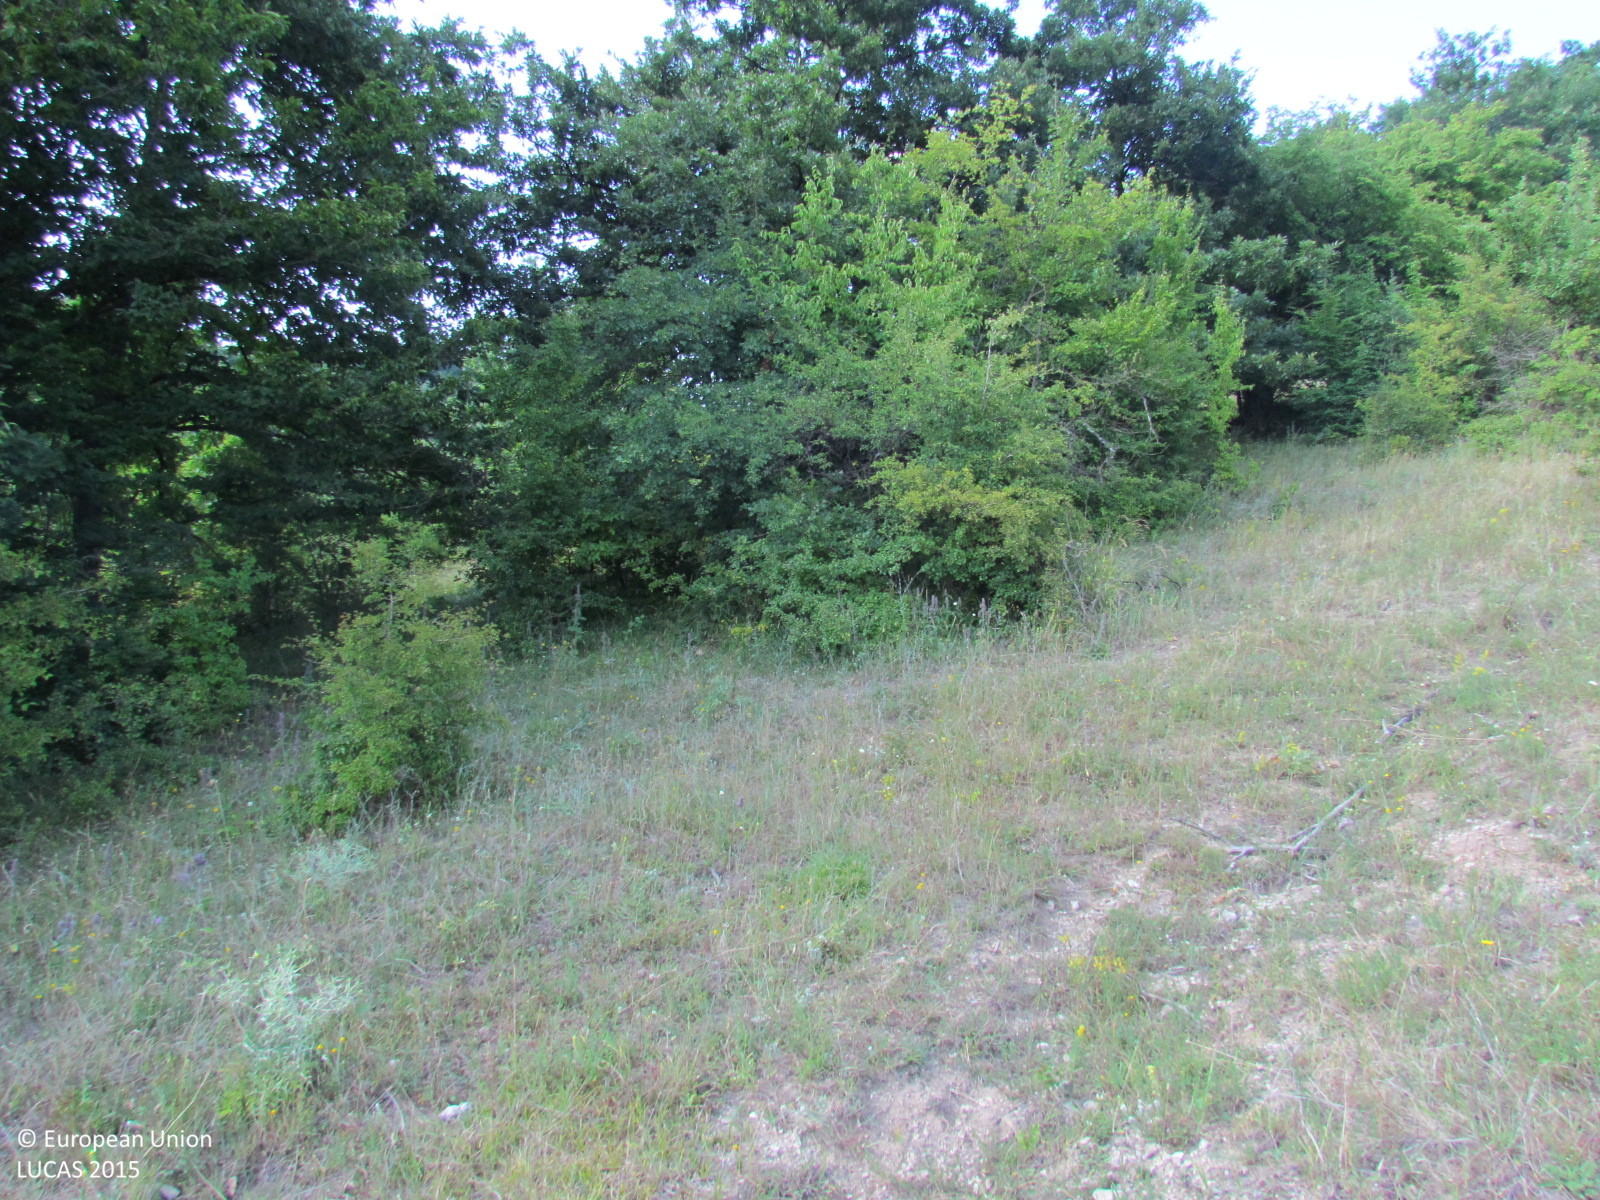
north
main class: Grassland
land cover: Grassland with sparse tree/shrub cover
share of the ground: > 75 %
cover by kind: herbaceous plants 90 %, broadleaved forest trees 5 %, shrubs 5 %
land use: Agriculture (excluding fallow land and kitchen gardens)
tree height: > 5 m
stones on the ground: < 10 %
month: July
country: BG
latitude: 42.8990
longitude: 27.4258
